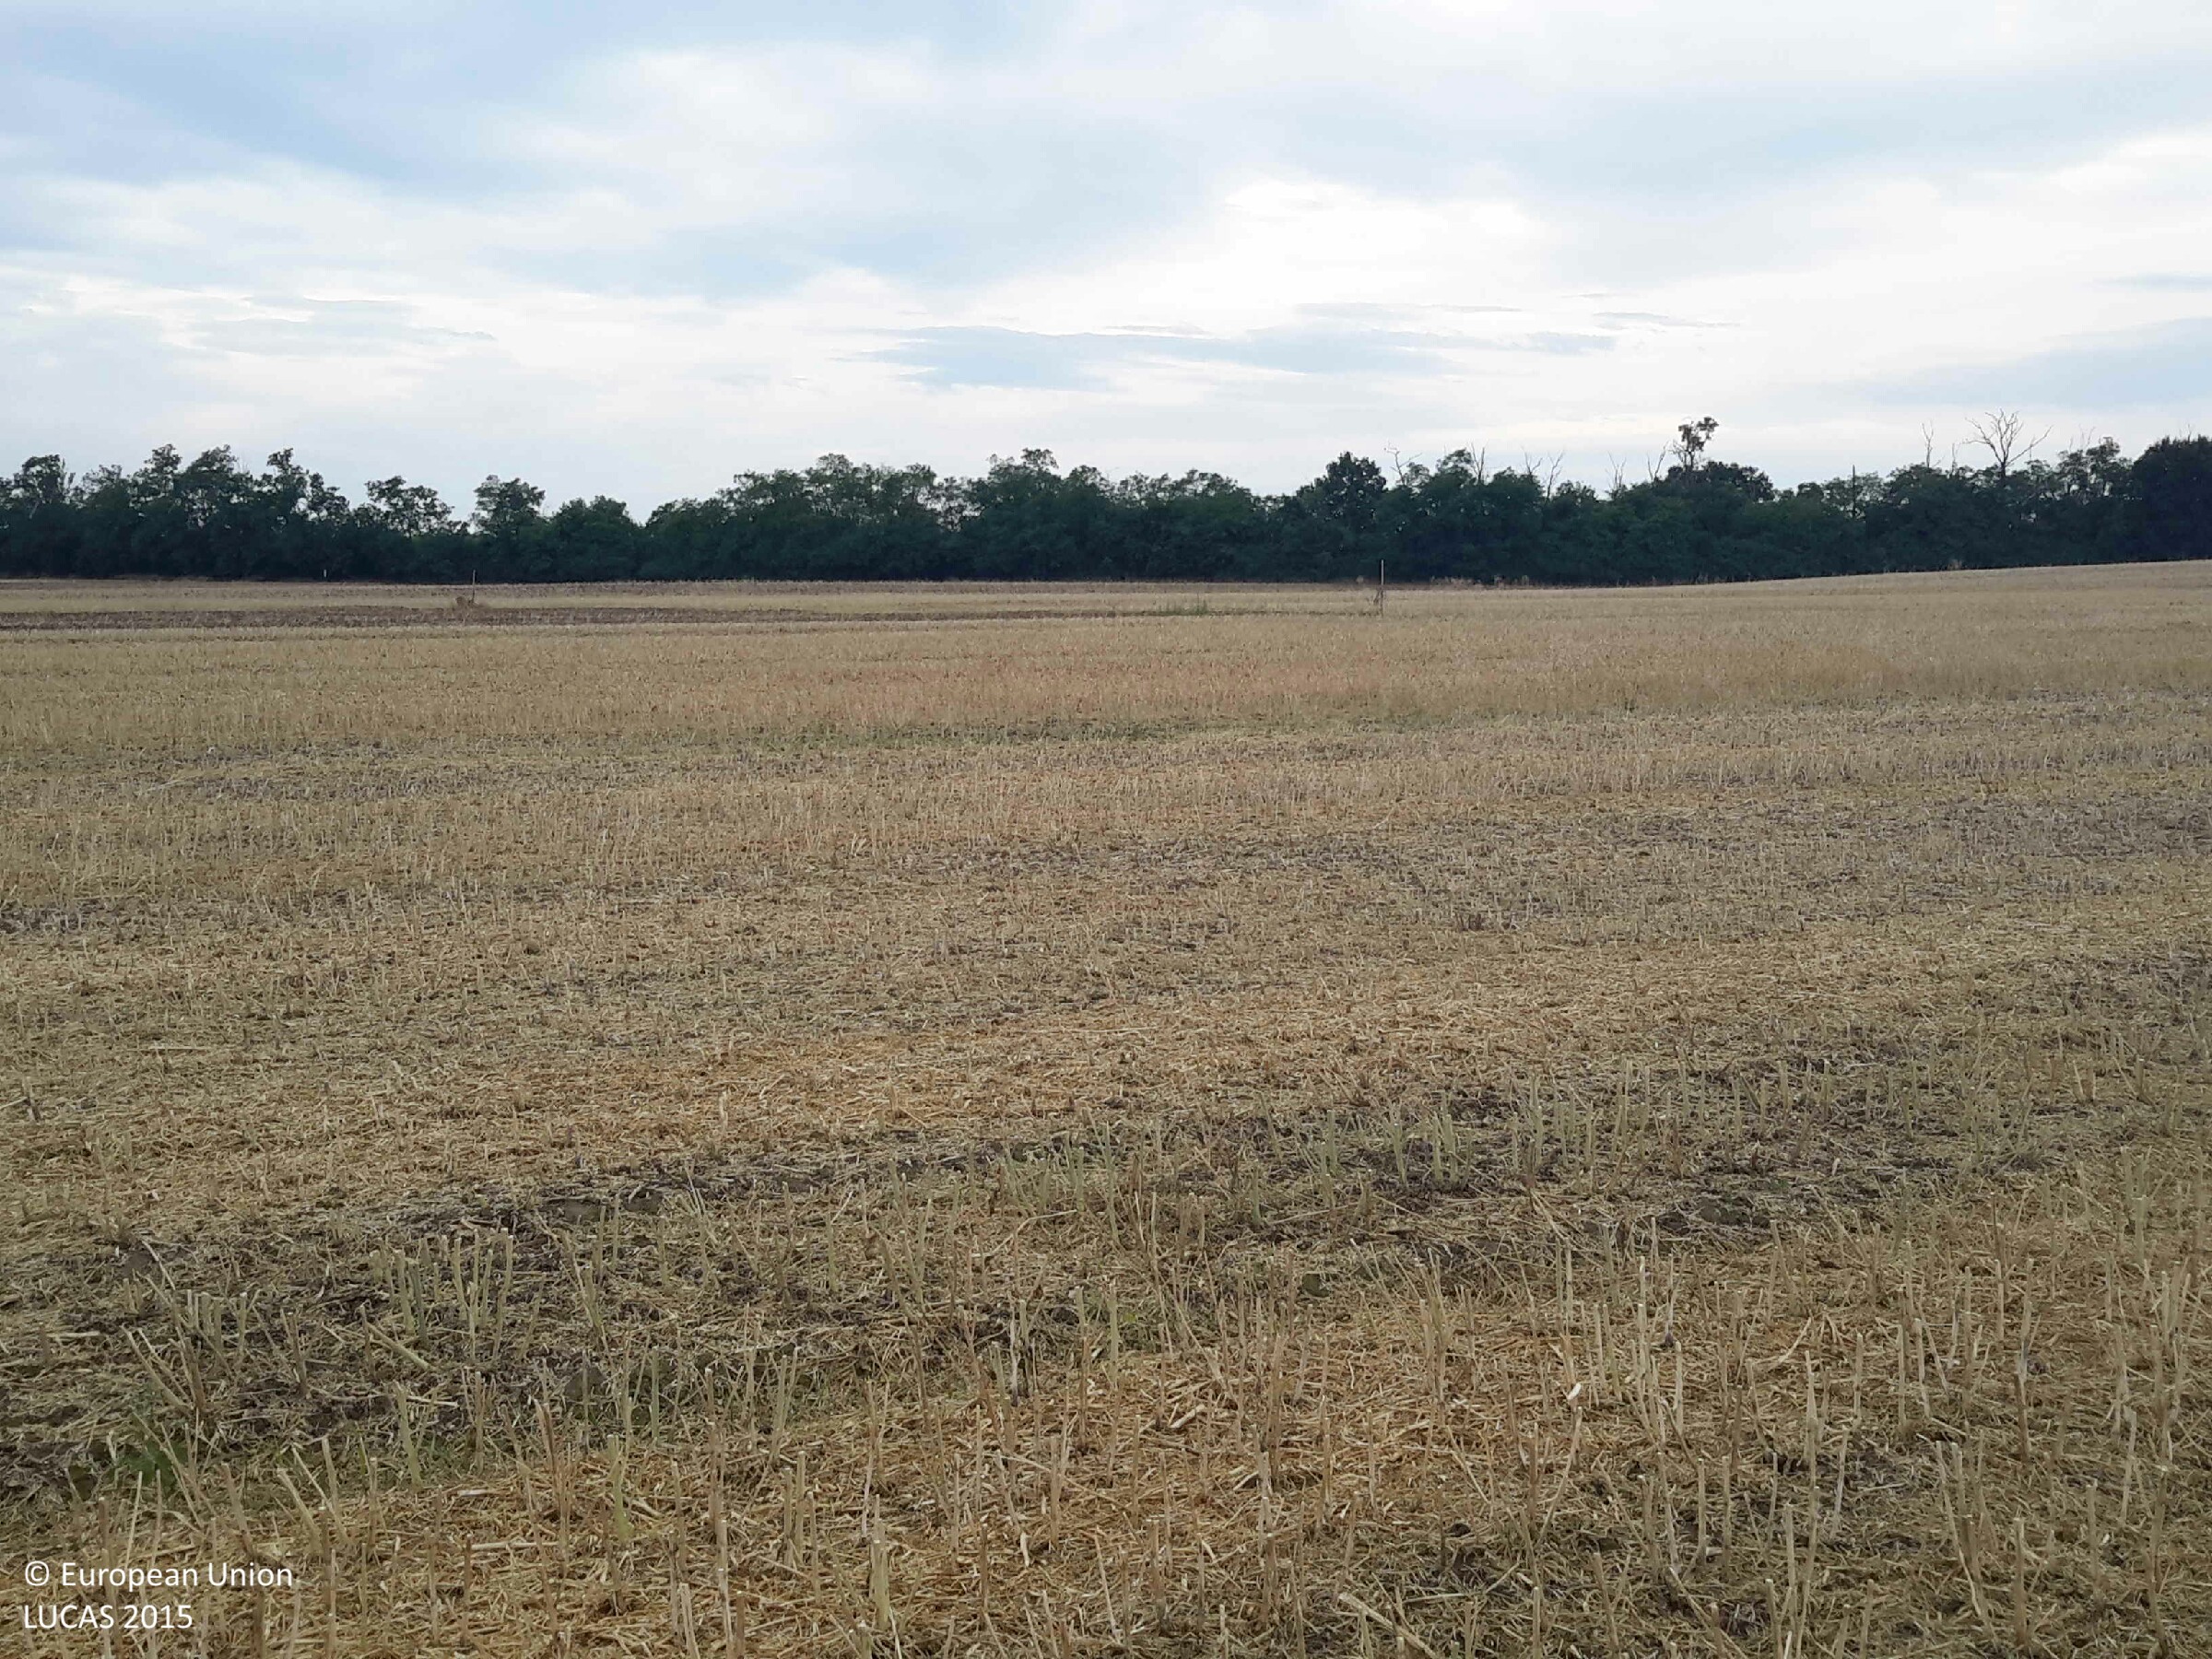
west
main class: Cropland
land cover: Rape and turnip rape
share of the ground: 10 - 25 %
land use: Agriculture (excluding fallow land and kitchen gardens)
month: July
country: HU
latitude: 47.4472
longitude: 17.1811
